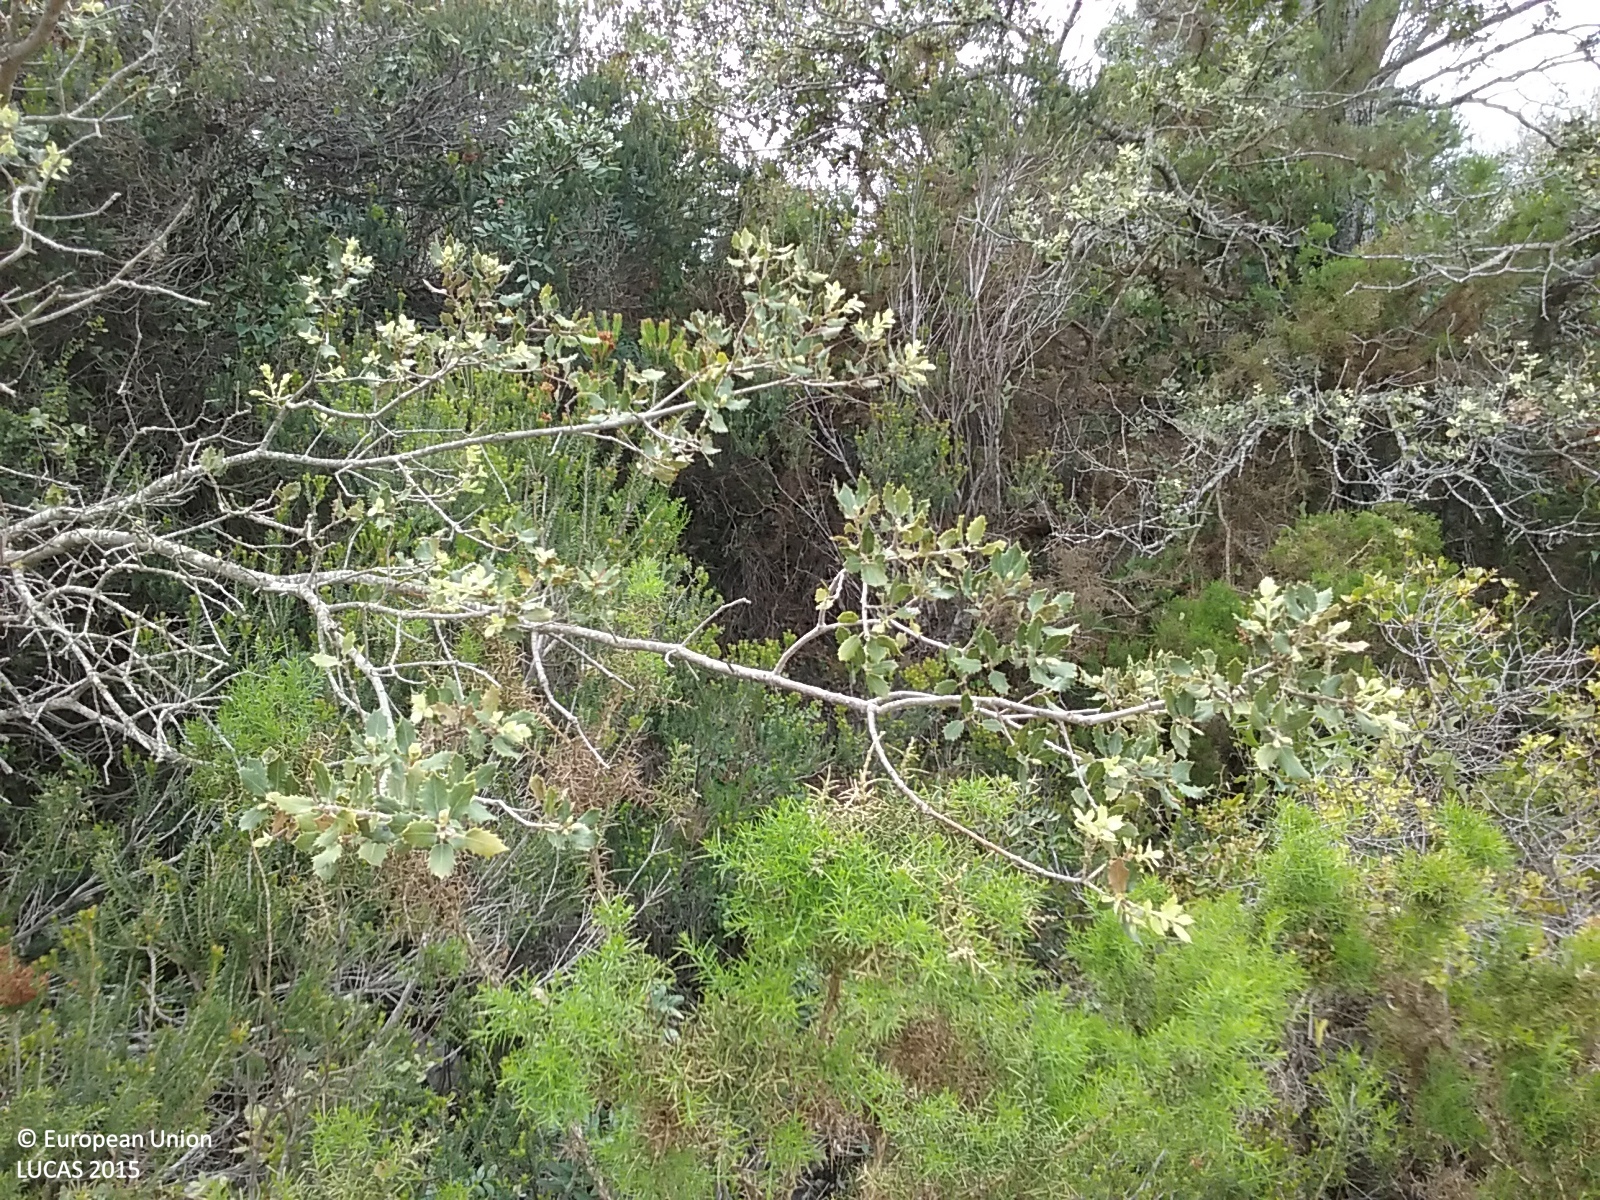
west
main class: Woodland
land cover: Broadleaved woodland
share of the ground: 10 - 25 %
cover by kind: shrubs 70 %, broadleaved forest trees 25 %, coniferous forest trees 5 %
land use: Semi-natural and natural areas not in use
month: April
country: ES
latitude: 40.5145
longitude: 0.3058
